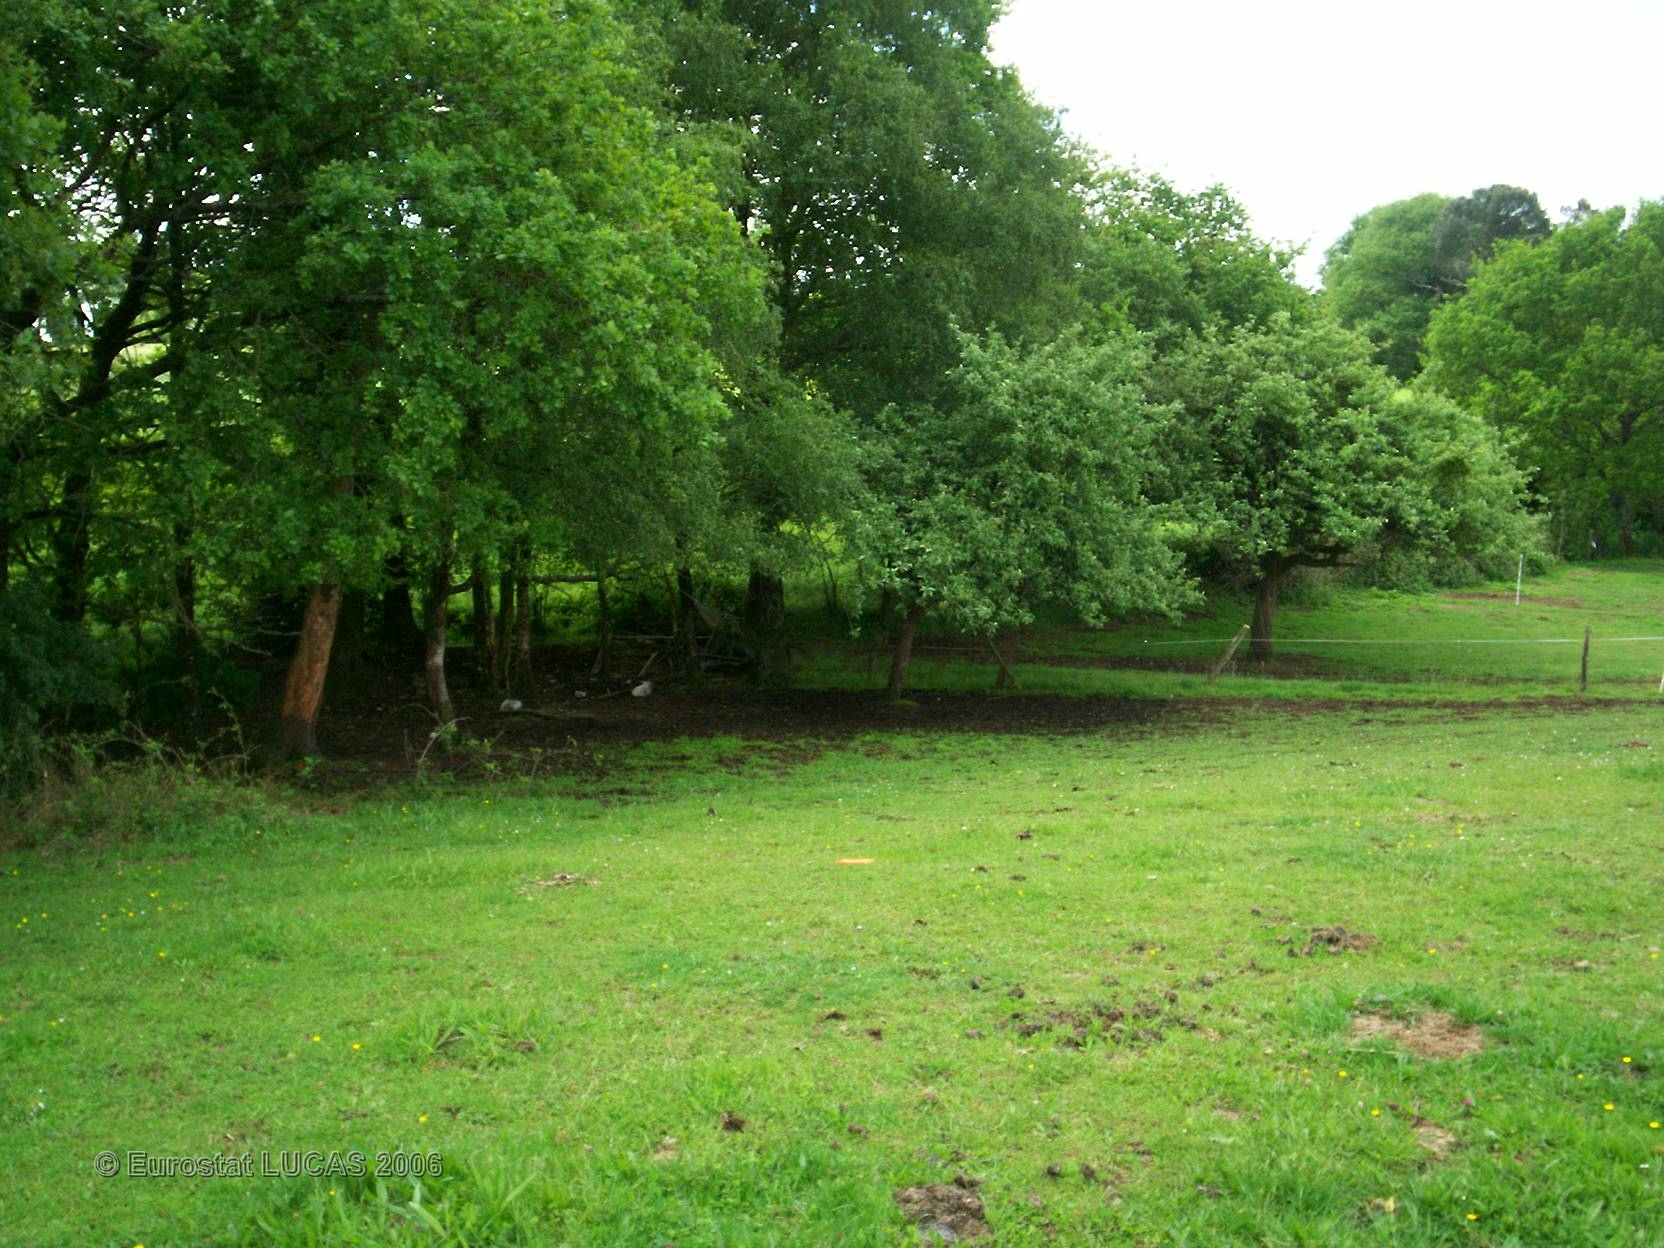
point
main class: Grassland
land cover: Grassland without tree/shrub cover
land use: Agriculture (excluding fallow land and kitchen gardens)
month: May
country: FR
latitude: 47.7292
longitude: -2.7961
